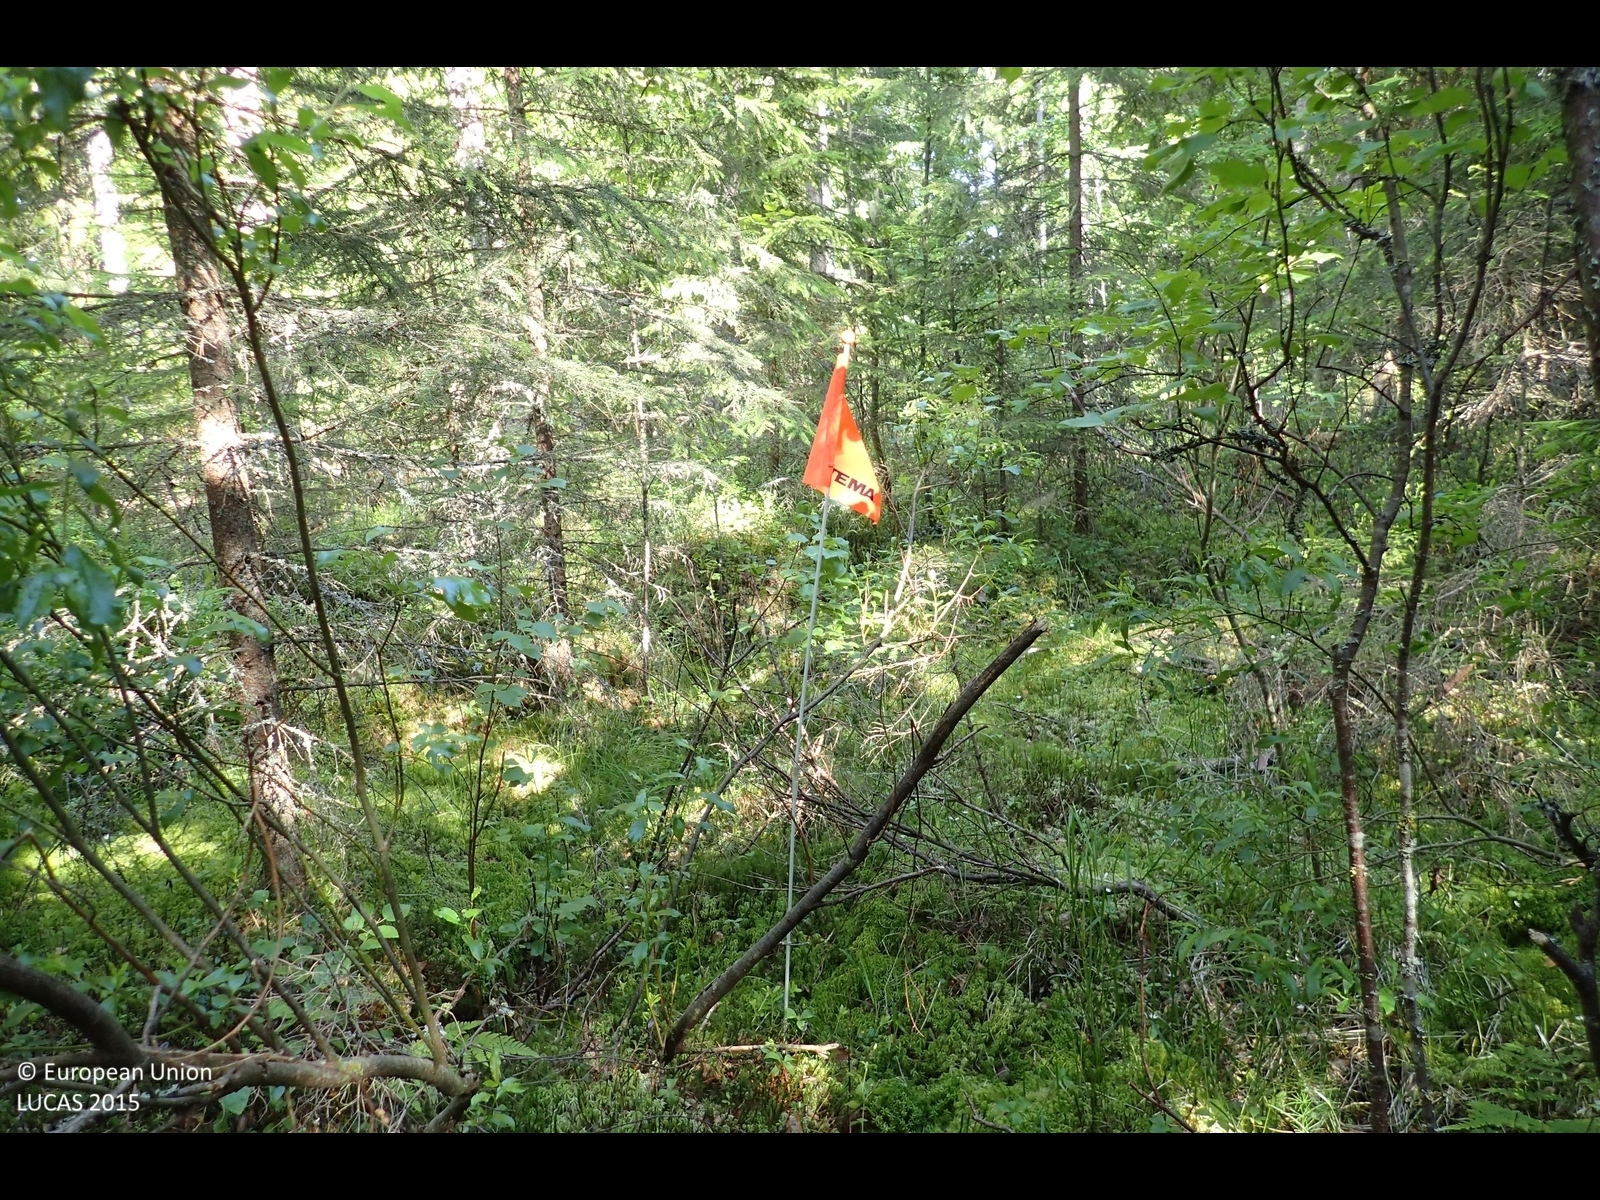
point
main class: Woodland
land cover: Other mixed woodland
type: boreal forest
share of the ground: > 75 %
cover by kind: coniferous forest trees 60 %, broadleaved forest trees 20 %, shrubs 10 %, lichens and mosses 10 %
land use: Forestry
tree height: > 5 m
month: July
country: FI
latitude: 62.6130
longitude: 21.6778
